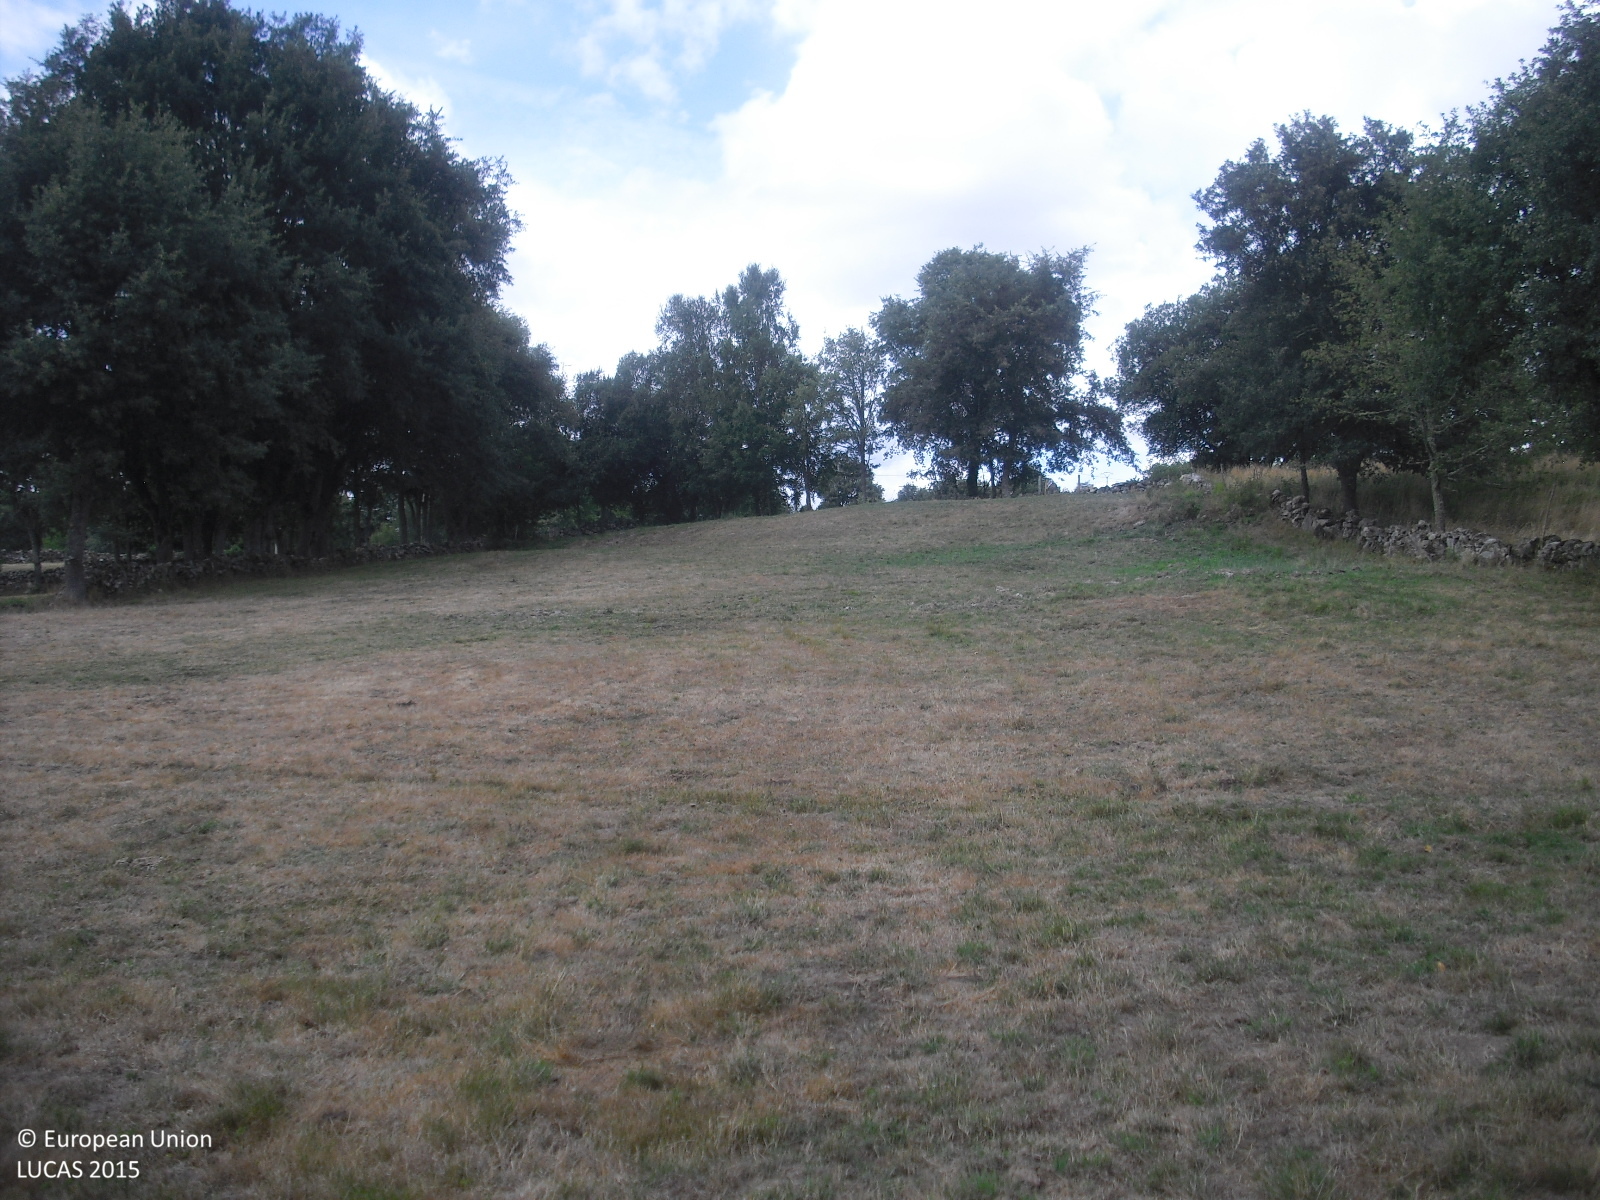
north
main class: Grassland
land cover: Grassland without tree/shrub cover
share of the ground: > 75 %
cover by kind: herbaceous plants 100 %
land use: Agriculture (excluding fallow land and kitchen gardens)
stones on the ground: < 10 %
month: July
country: ES
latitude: 42.3620
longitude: -7.4407
